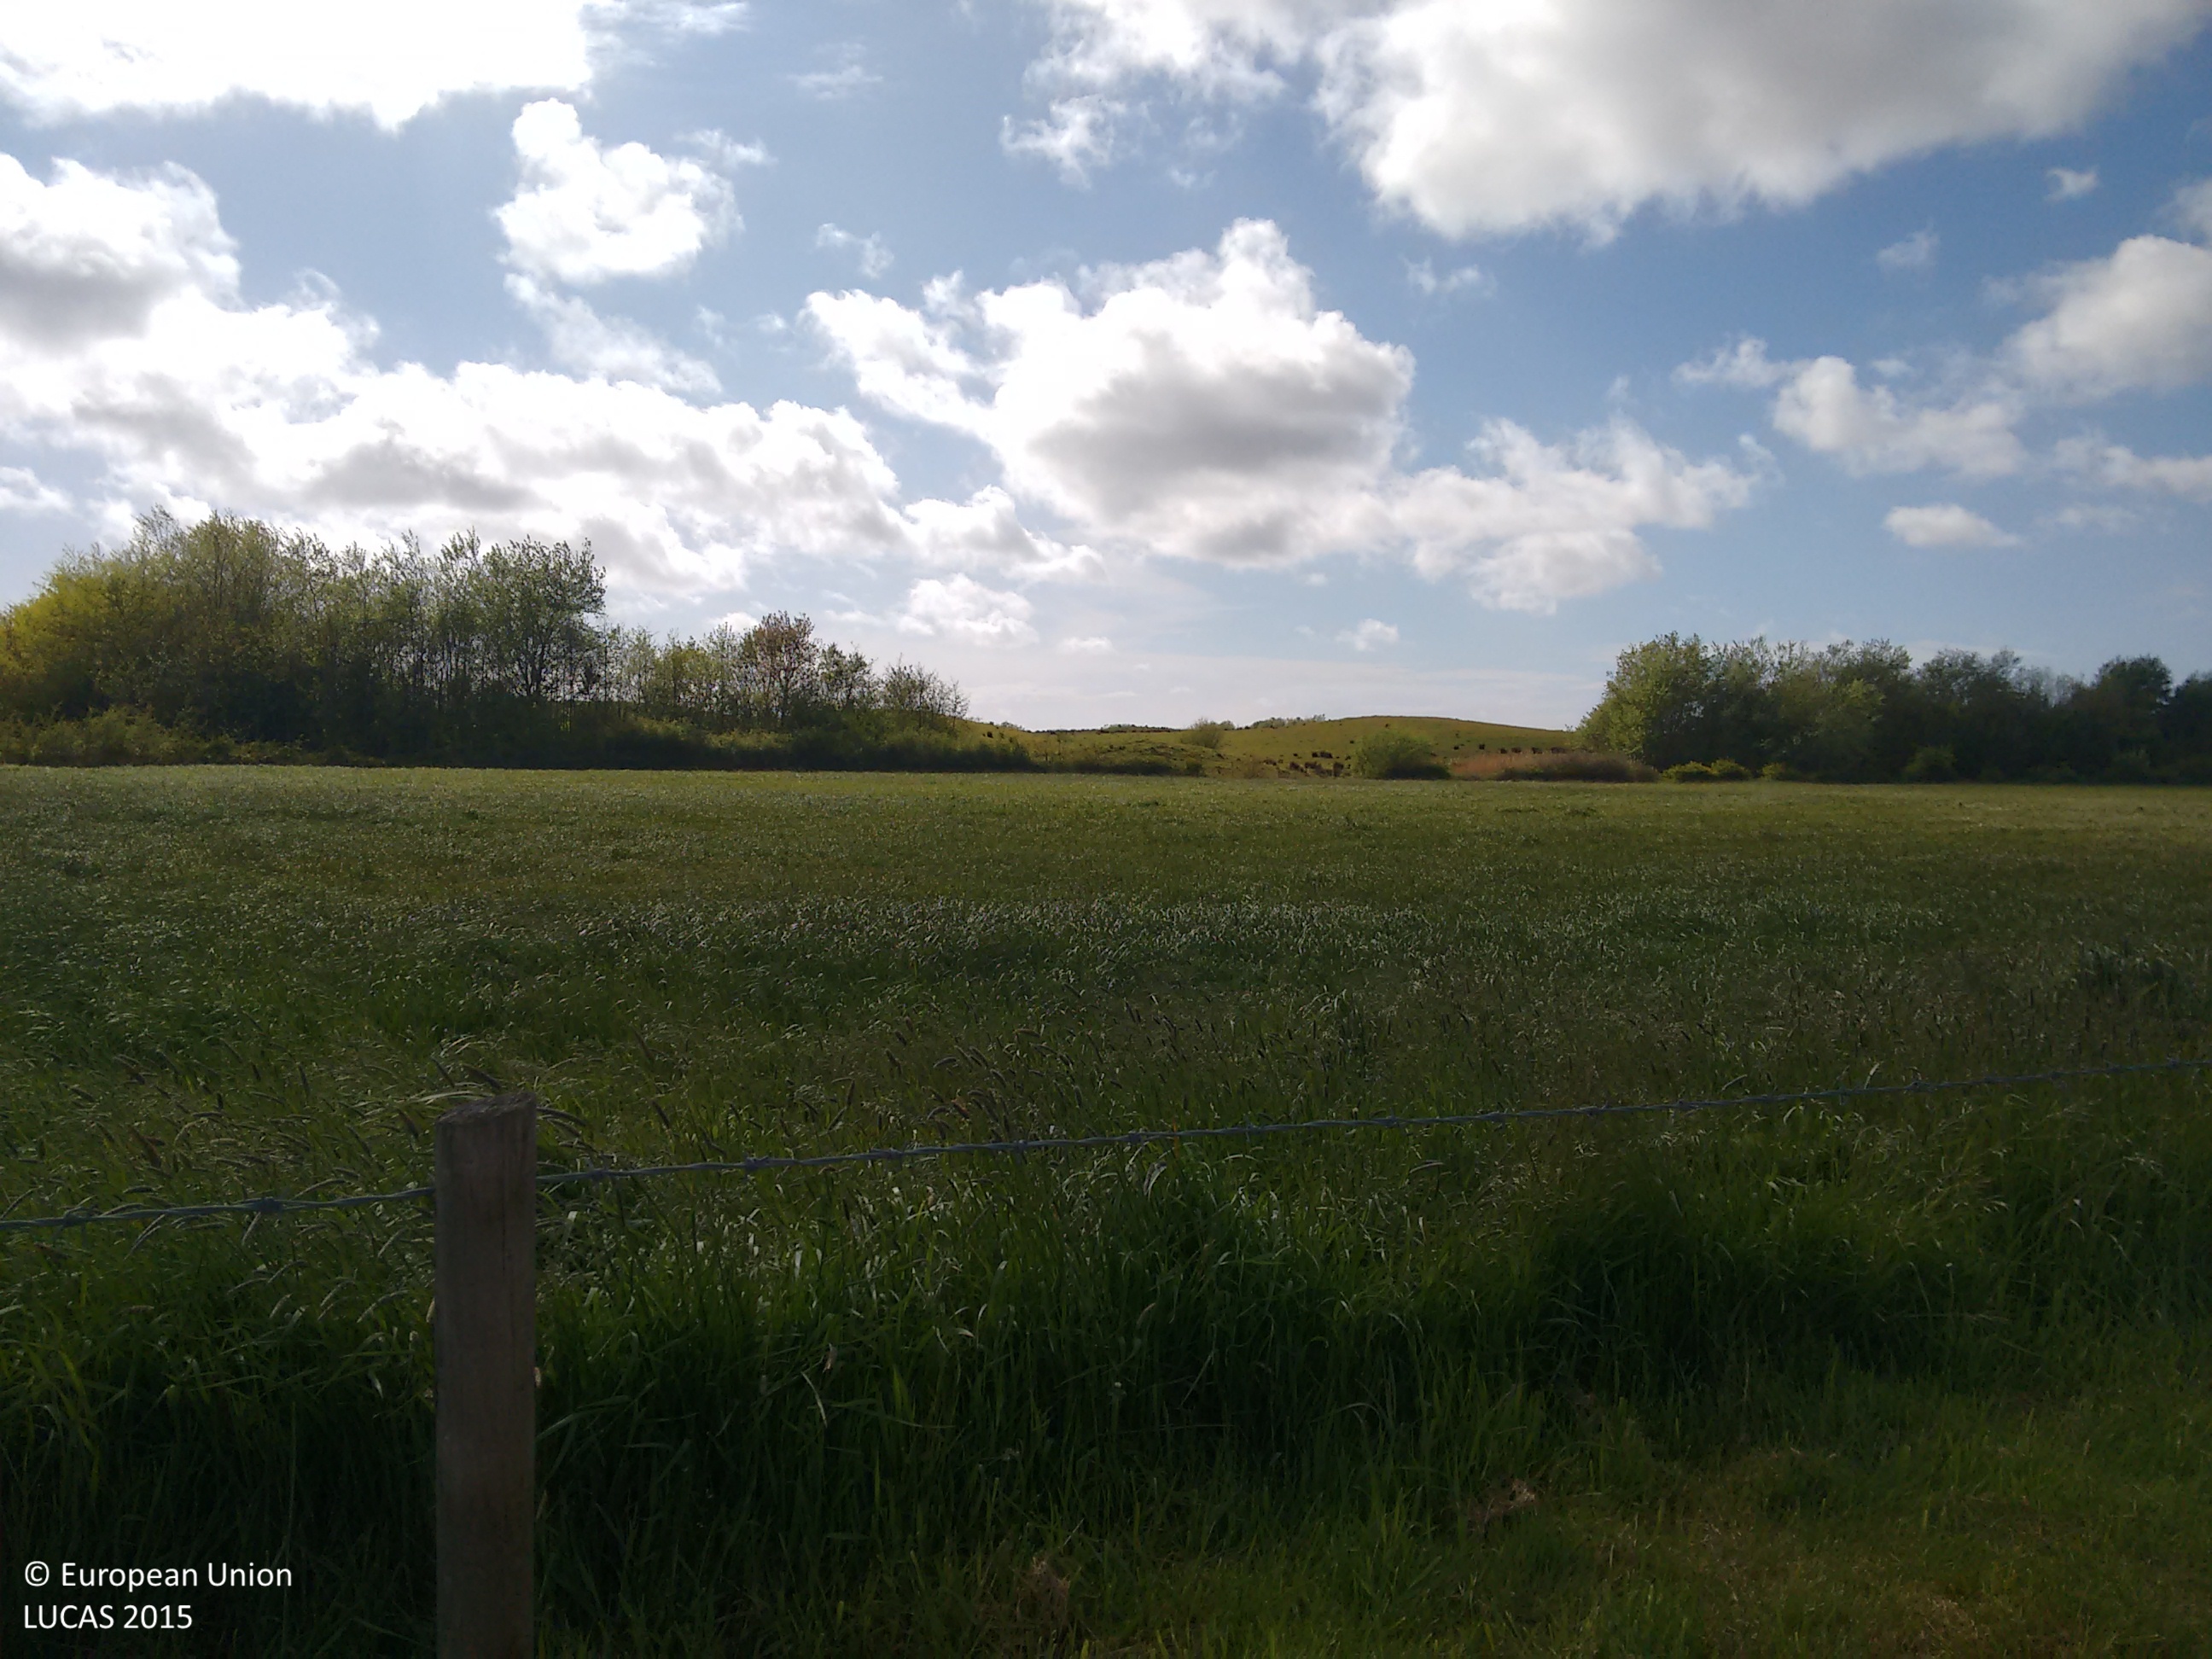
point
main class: Grassland
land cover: Grassland without tree/shrub cover
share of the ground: > 75 %
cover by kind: herbaceous plants 100 %
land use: Construction
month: May
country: GB
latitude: 53.8542
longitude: -2.9183
